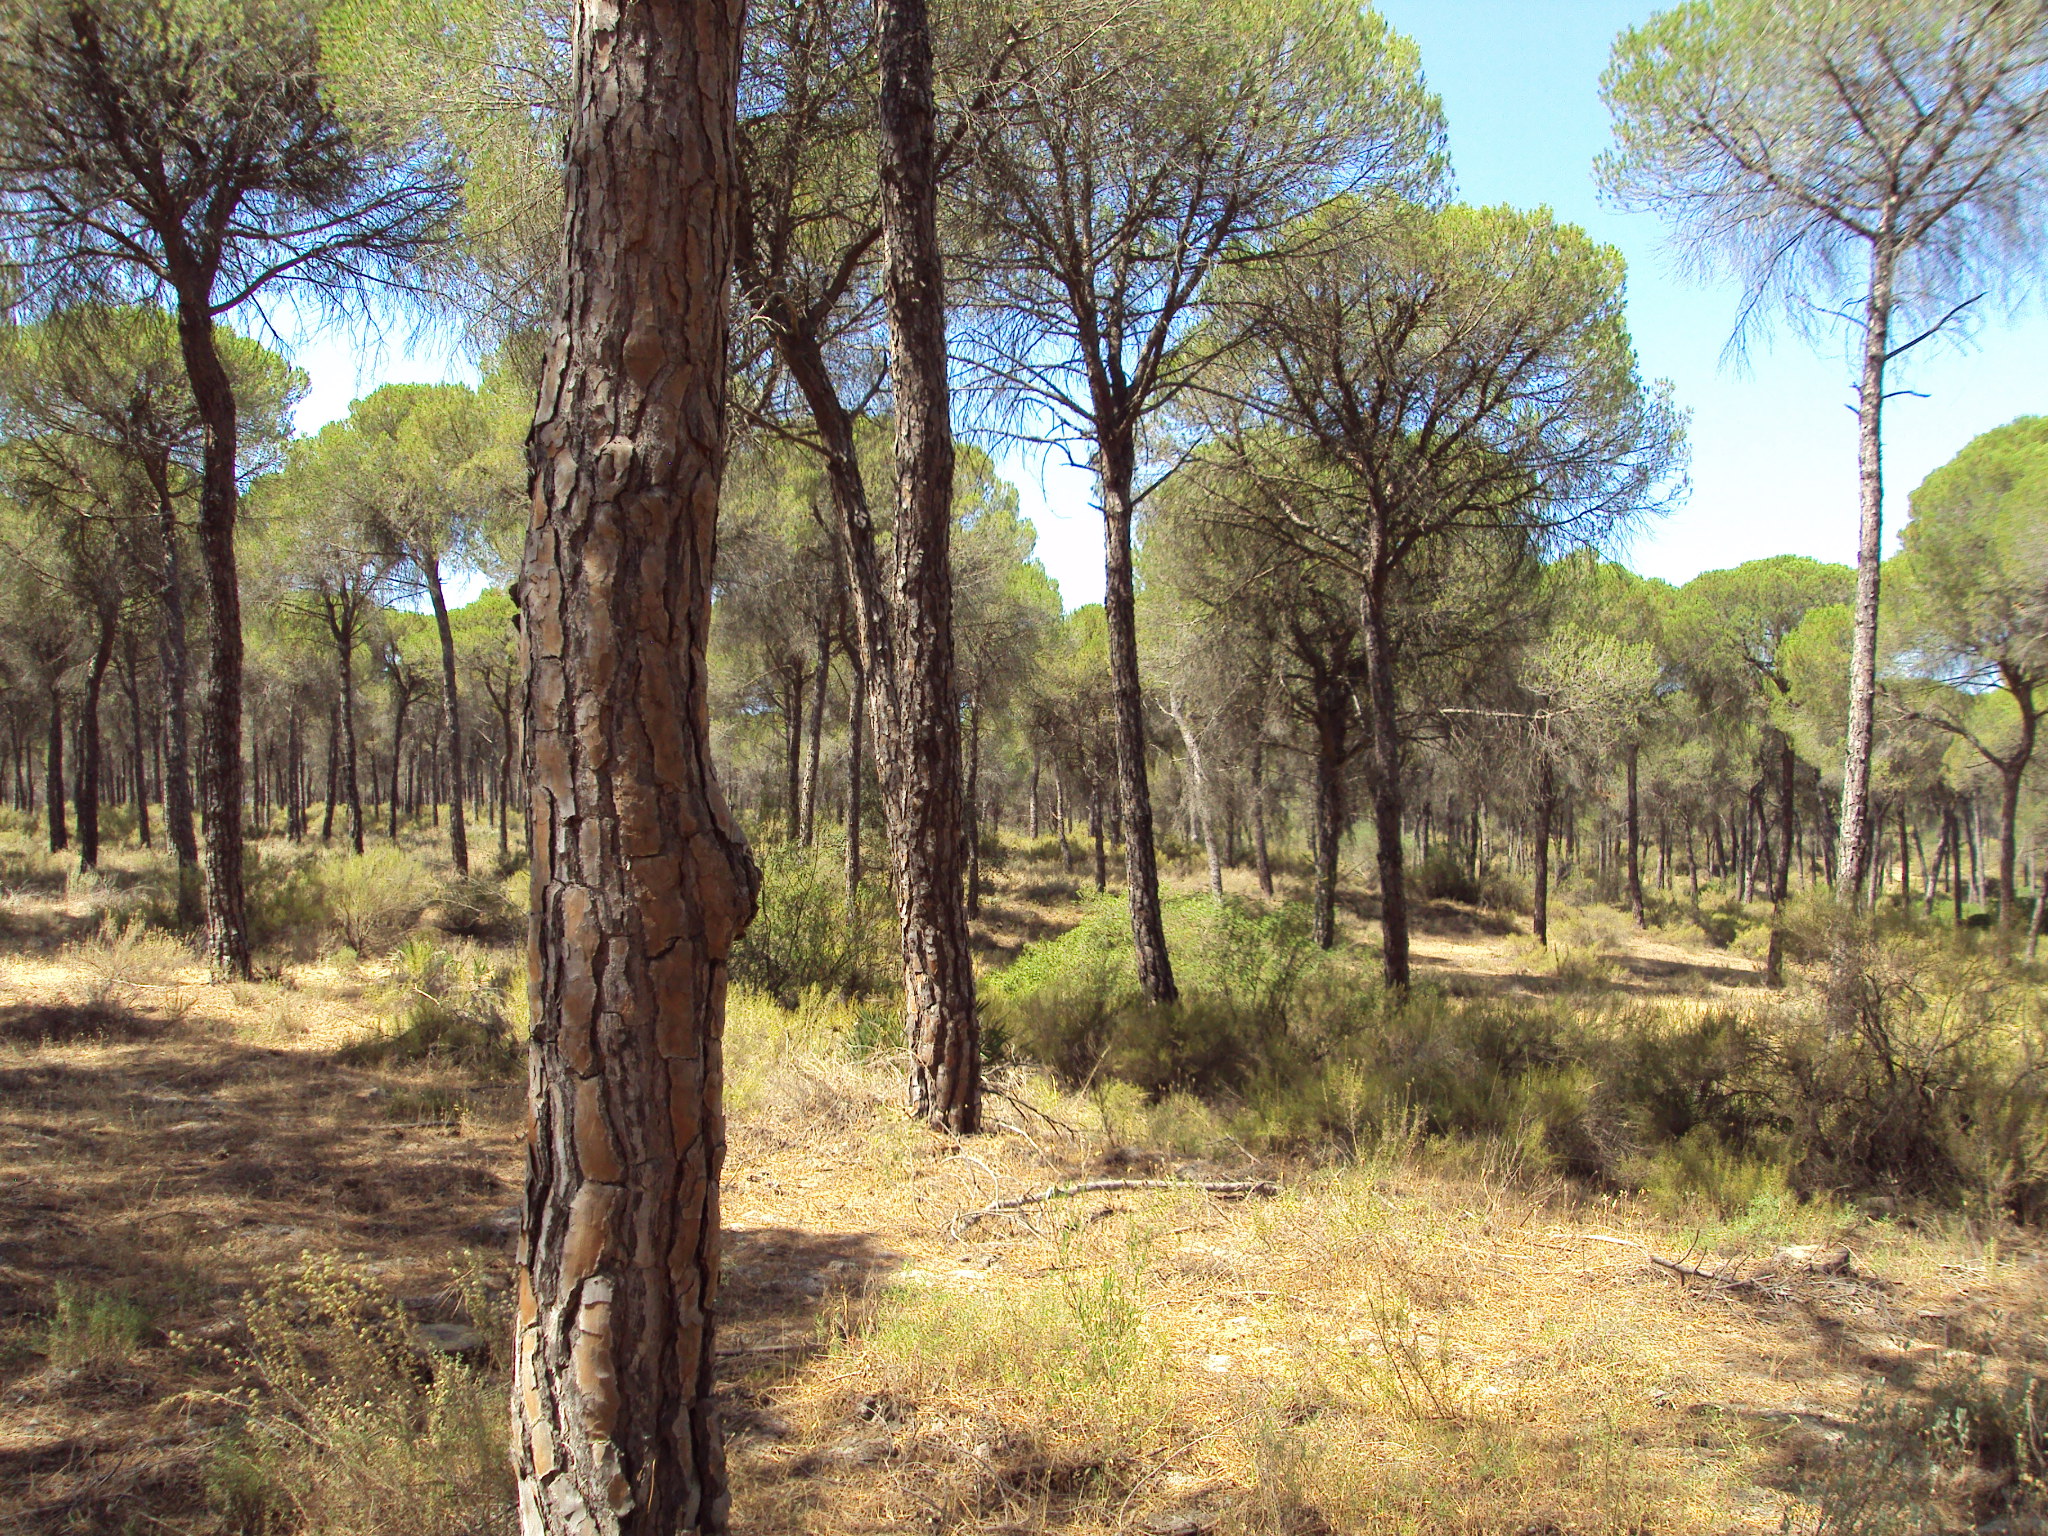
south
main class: Woodland
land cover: Pine dominated coniferous woodland
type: coniferous forest of the mediterranean region
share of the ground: 50 - 75 %
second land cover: Spontaneously vegetated surfaces
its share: > 75 %
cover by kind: coniferous forest trees 60 %, shrubs 30 %, herbaceous plants 10 %
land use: Forestry
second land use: Agriculture (excluding fallow land and kitchen gardens)
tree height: > 5 m
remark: Clear cut
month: July
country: ES
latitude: 37.2255
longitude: -6.5640
